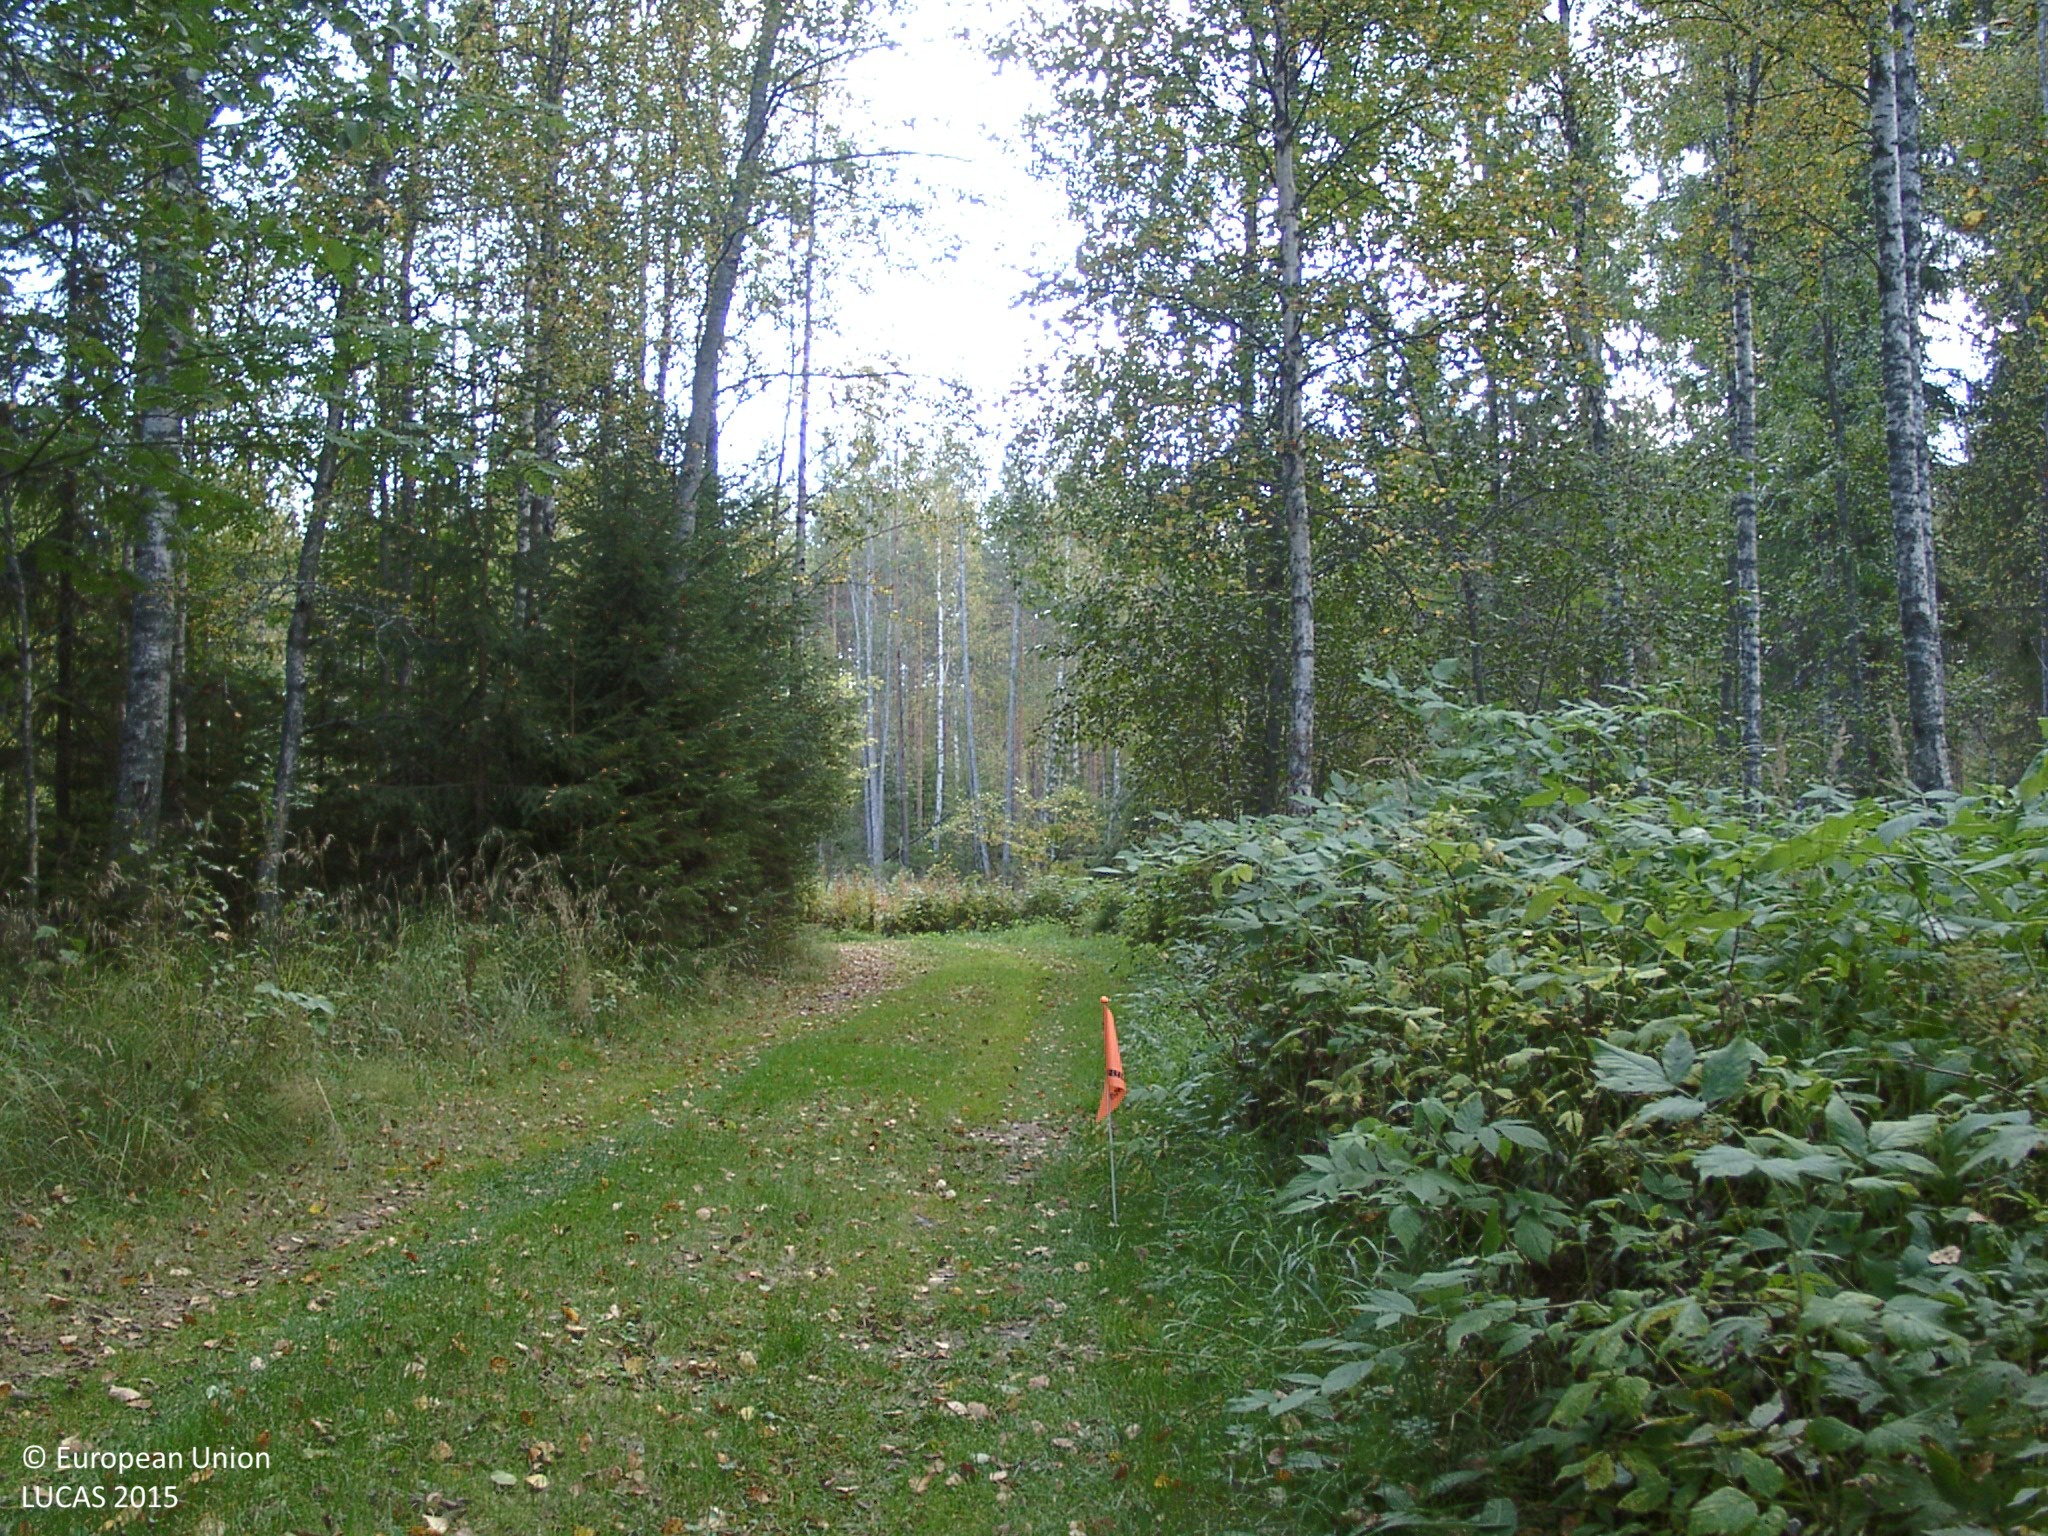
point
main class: Artificial land
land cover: Non built-up linear features
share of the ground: > 75 %
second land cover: Grassland without tree/shrub cover
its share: 50 - 75 %
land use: Road transport
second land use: Residential
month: September
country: FI
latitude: 62.4907
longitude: 25.6206
